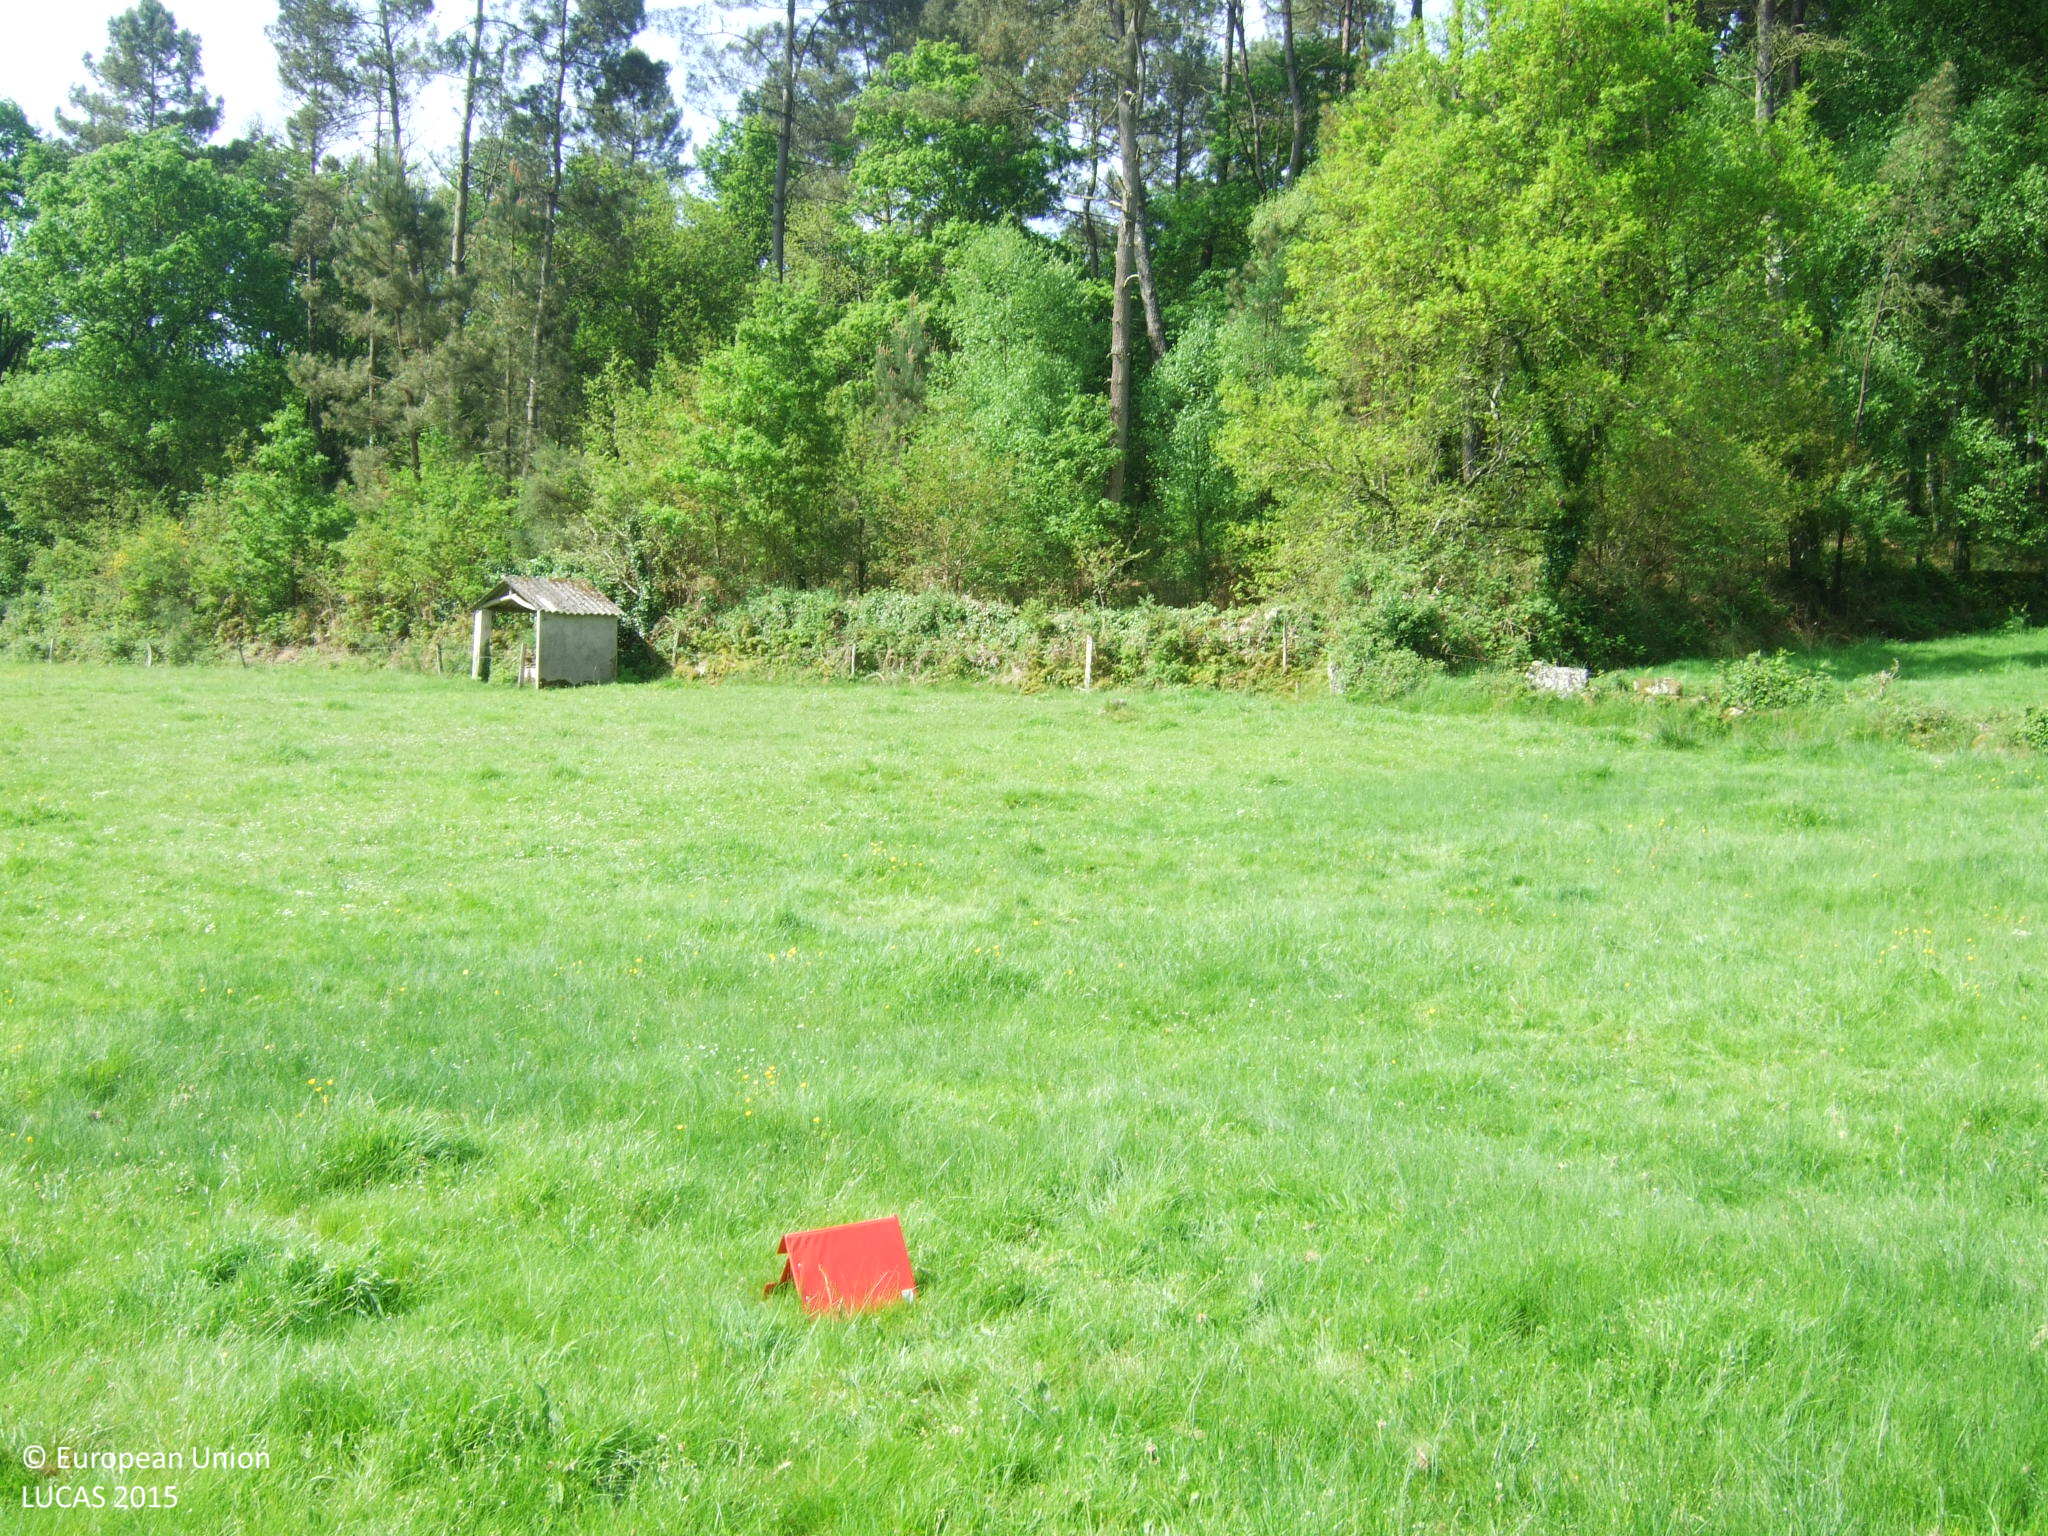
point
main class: Grassland
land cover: Grassland without tree/shrub cover
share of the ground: > 75 %
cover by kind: herbaceous plants 100 %
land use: Agriculture (excluding fallow land and kitchen gardens)
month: May
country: ES
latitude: 43.0082
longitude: -7.4335
